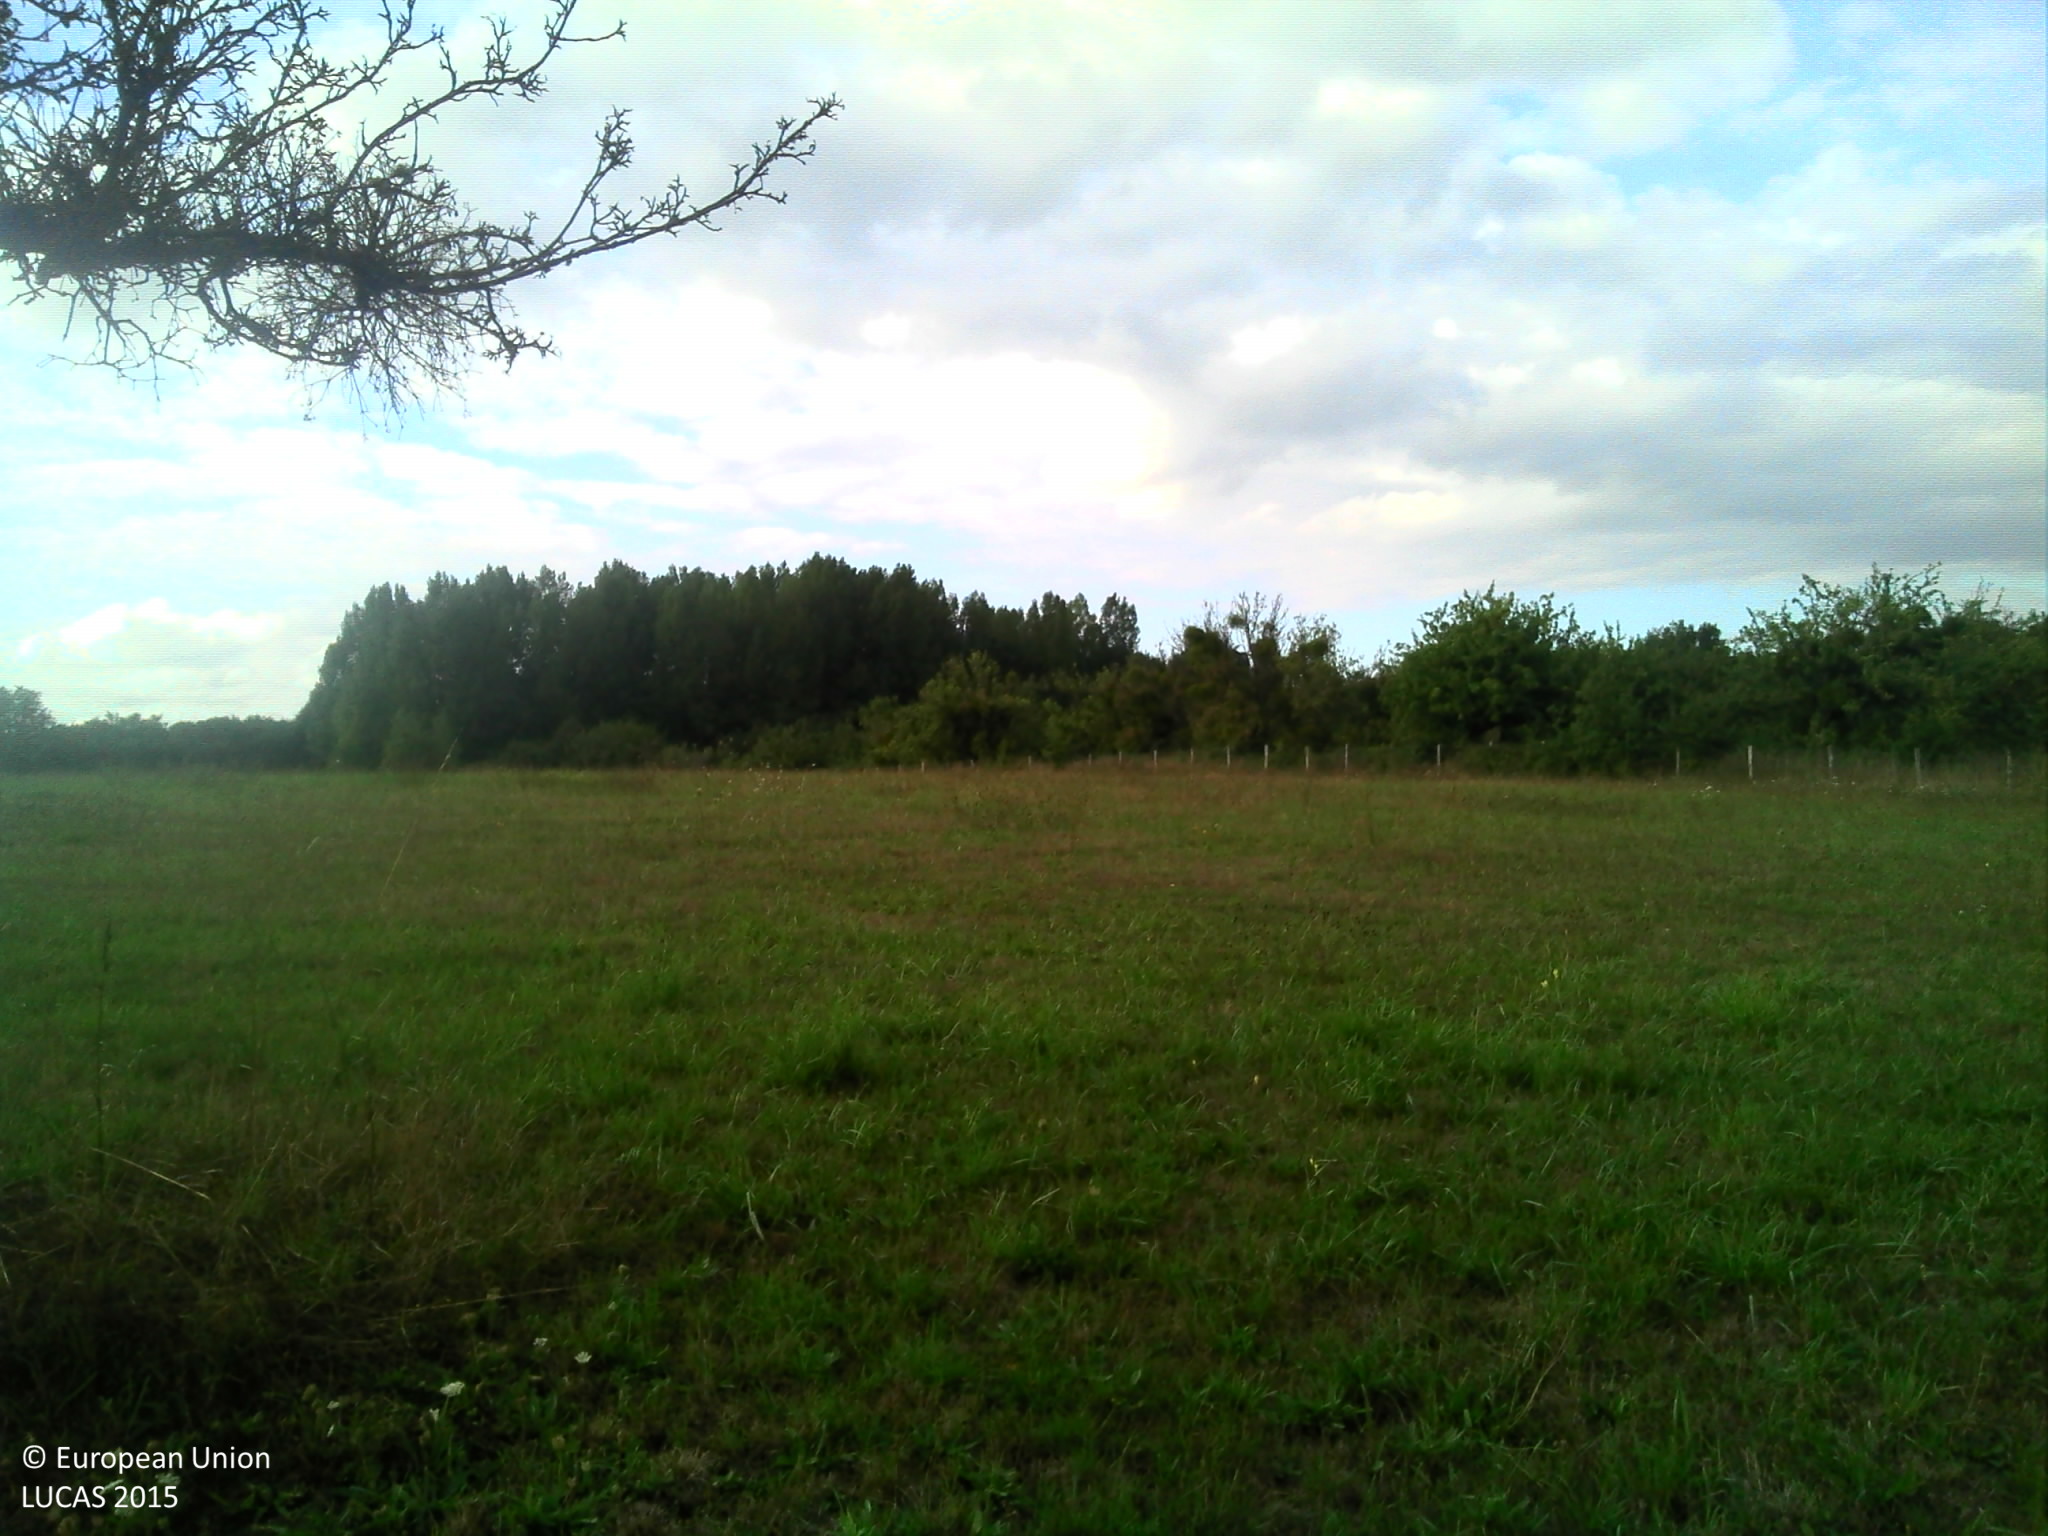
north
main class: Grassland
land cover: Grassland without tree/shrub cover
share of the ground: > 75 %
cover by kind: herbaceous plants 100 %
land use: Agriculture (excluding fallow land and kitchen gardens)
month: September
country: FR
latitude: 48.4201
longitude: 0.8303
